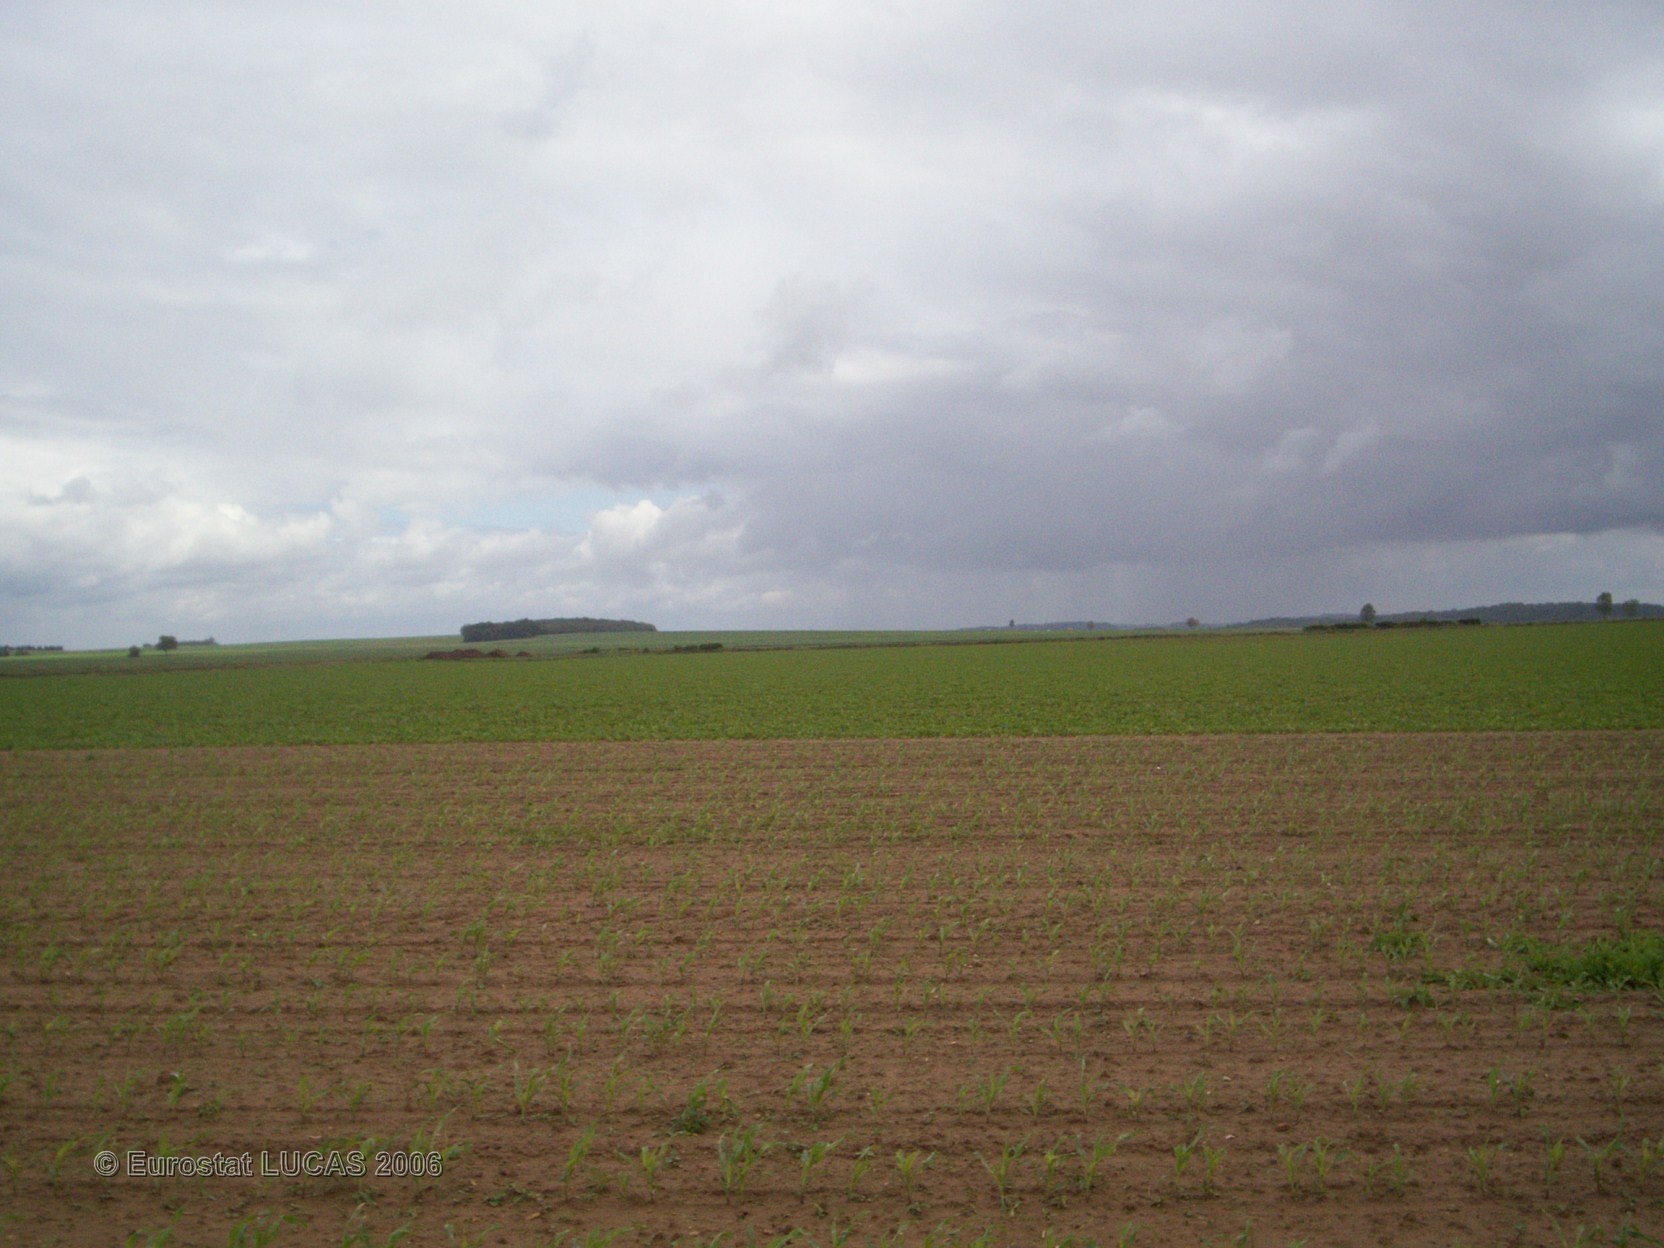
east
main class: Cropland
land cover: Maize
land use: Agriculture (excluding fallow land and kitchen gardens)
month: May
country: FR
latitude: 49.2330
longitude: 2.7798
